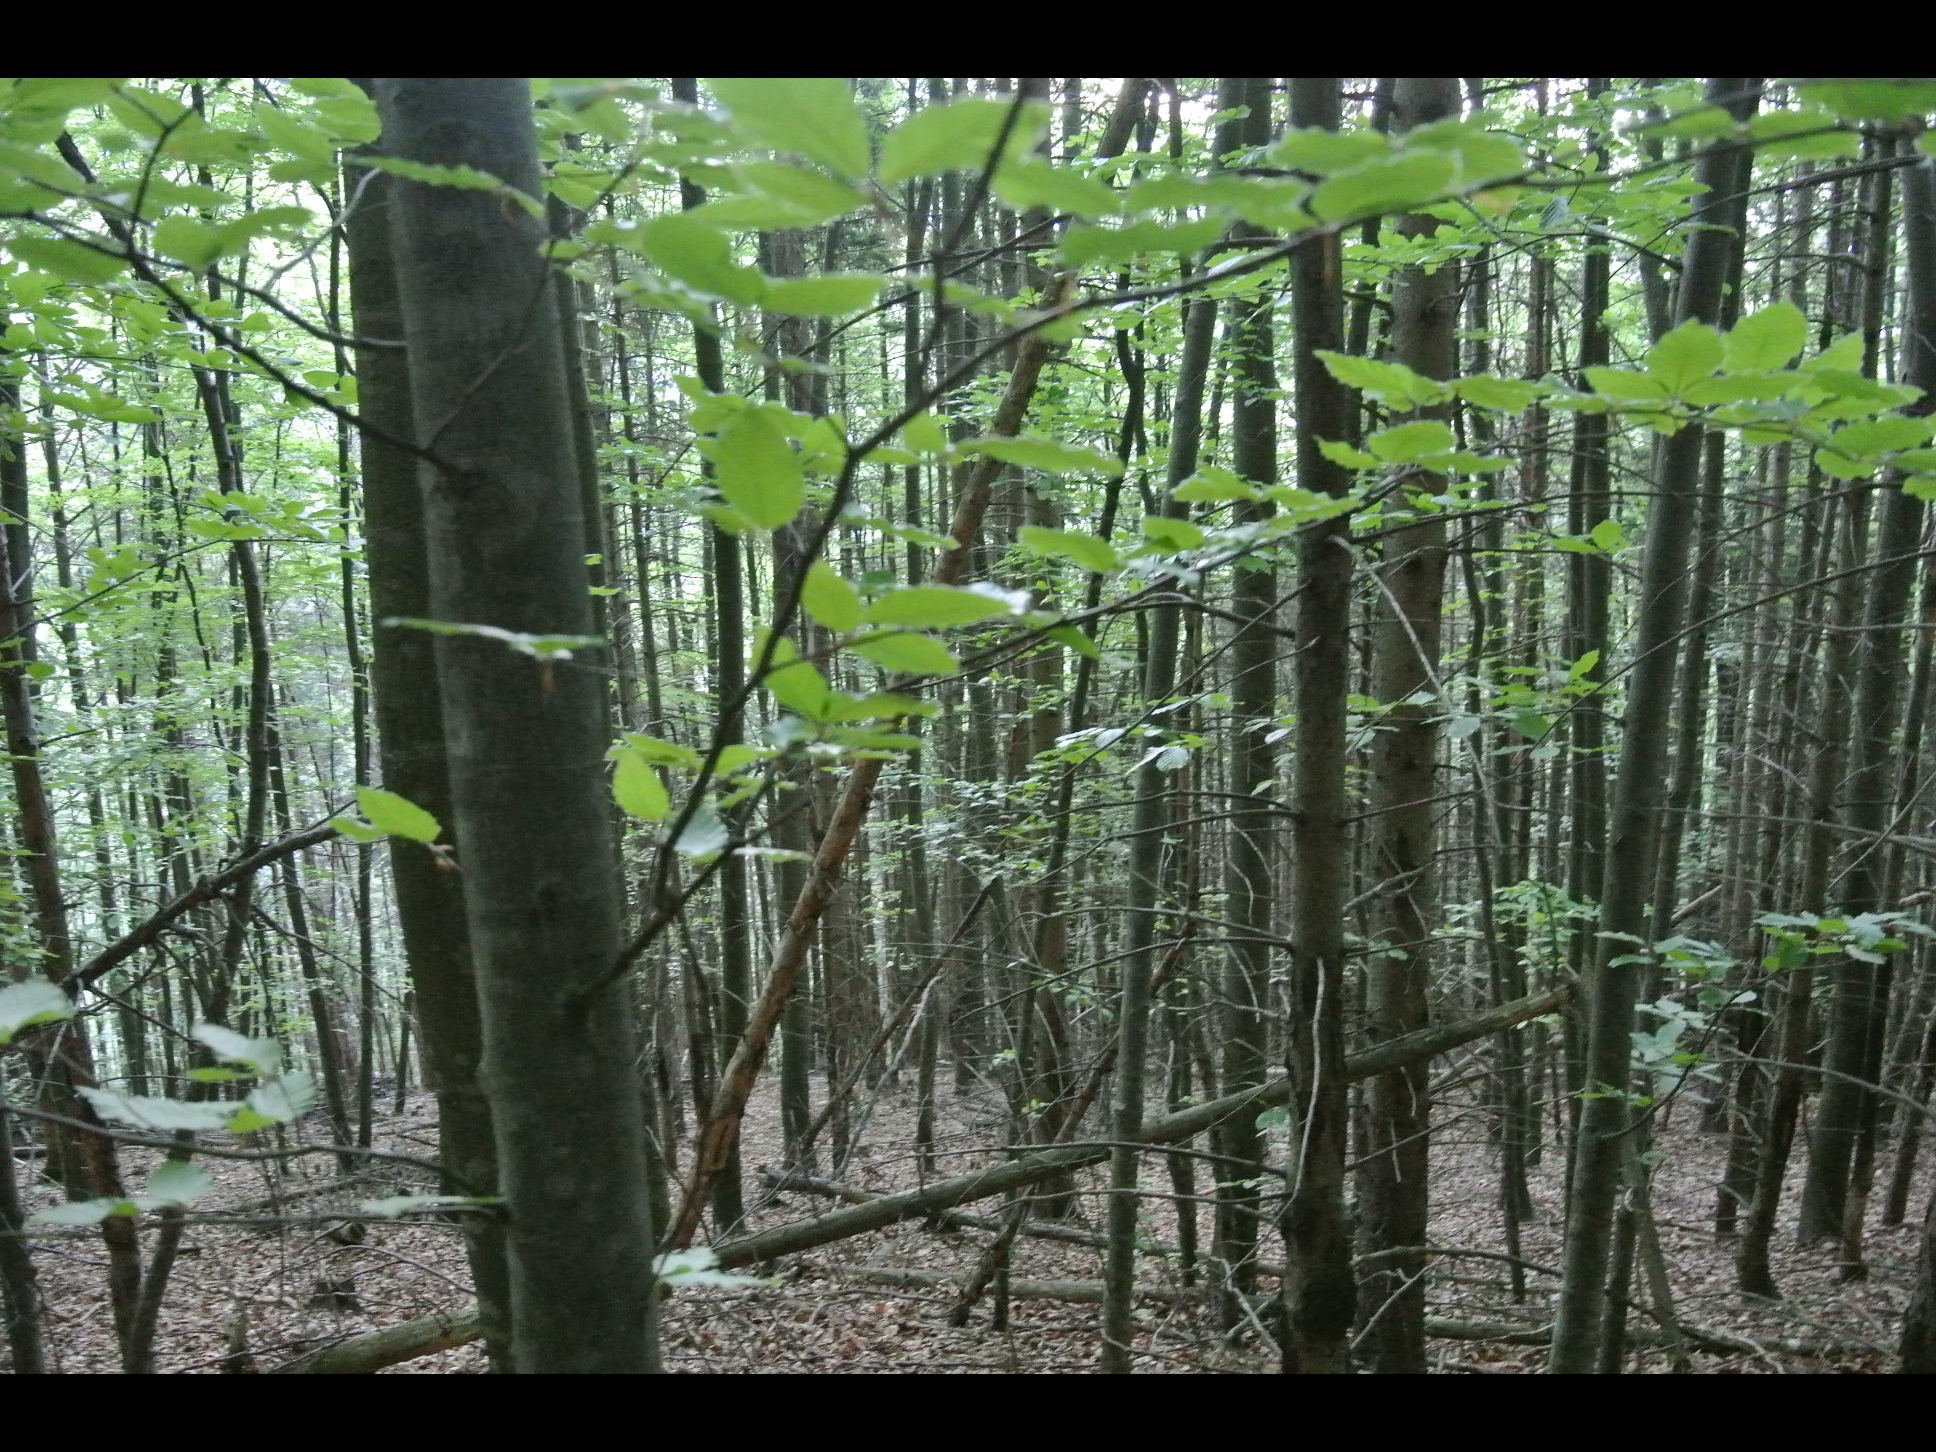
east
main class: Woodland
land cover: Broadleaved woodland
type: beech forest
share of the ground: > 75 %
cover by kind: broadleaved forest trees 100 %
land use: Forestry
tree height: > 5 m
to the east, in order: Broadleaved woodland; Spruce dominated mixed woodland; Broadleaved woodland; Tracks; Spruce dominated mixed woodland
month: May
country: AT
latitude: 47.7100
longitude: 15.7999
